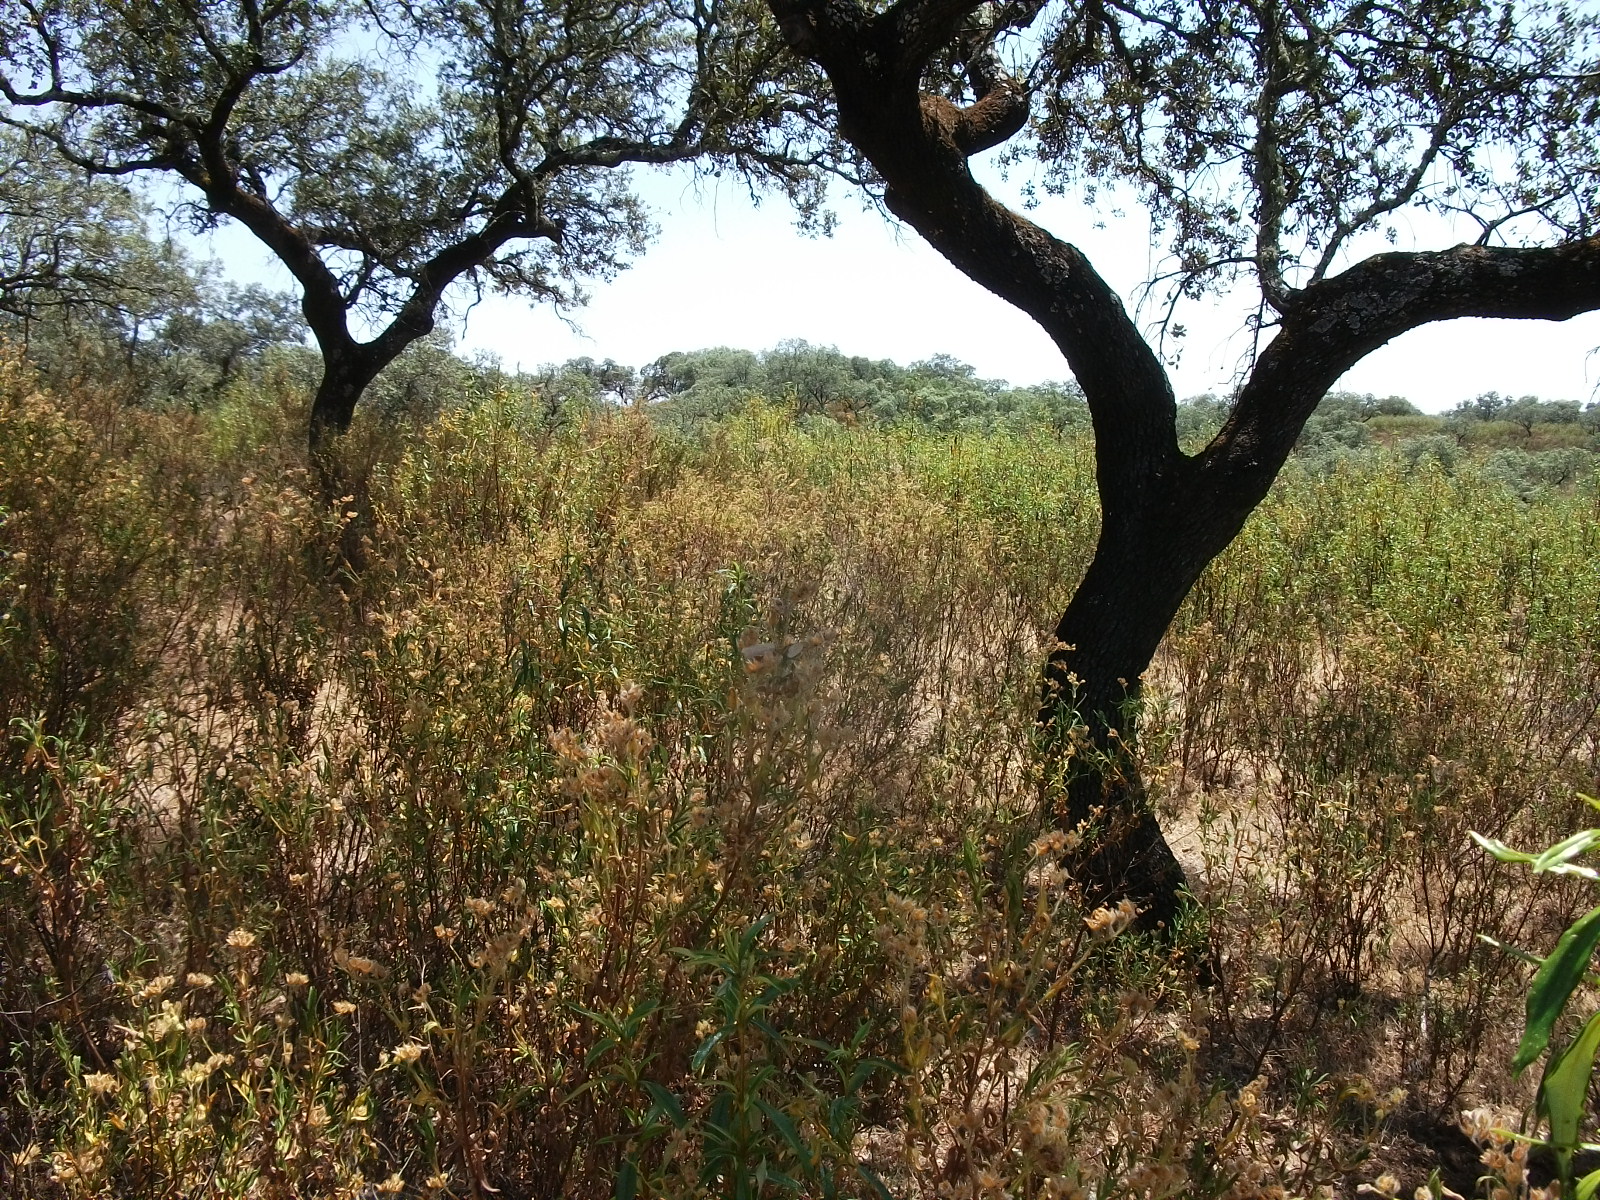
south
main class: Woodland
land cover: Broadleaved woodland
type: broadleaved evergreen forest
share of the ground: 50 - 75 %
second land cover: Spontaneously vegetated surfaces
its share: 25 - 50 %
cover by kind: broadleaved forest trees 60 %, shrubs 30 %, herbaceous plants 10 %
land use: Forestry
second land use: Agriculture (excluding fallow land and kitchen gardens)
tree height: > 5 m
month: June
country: ES
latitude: 37.5453
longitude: -6.9422
